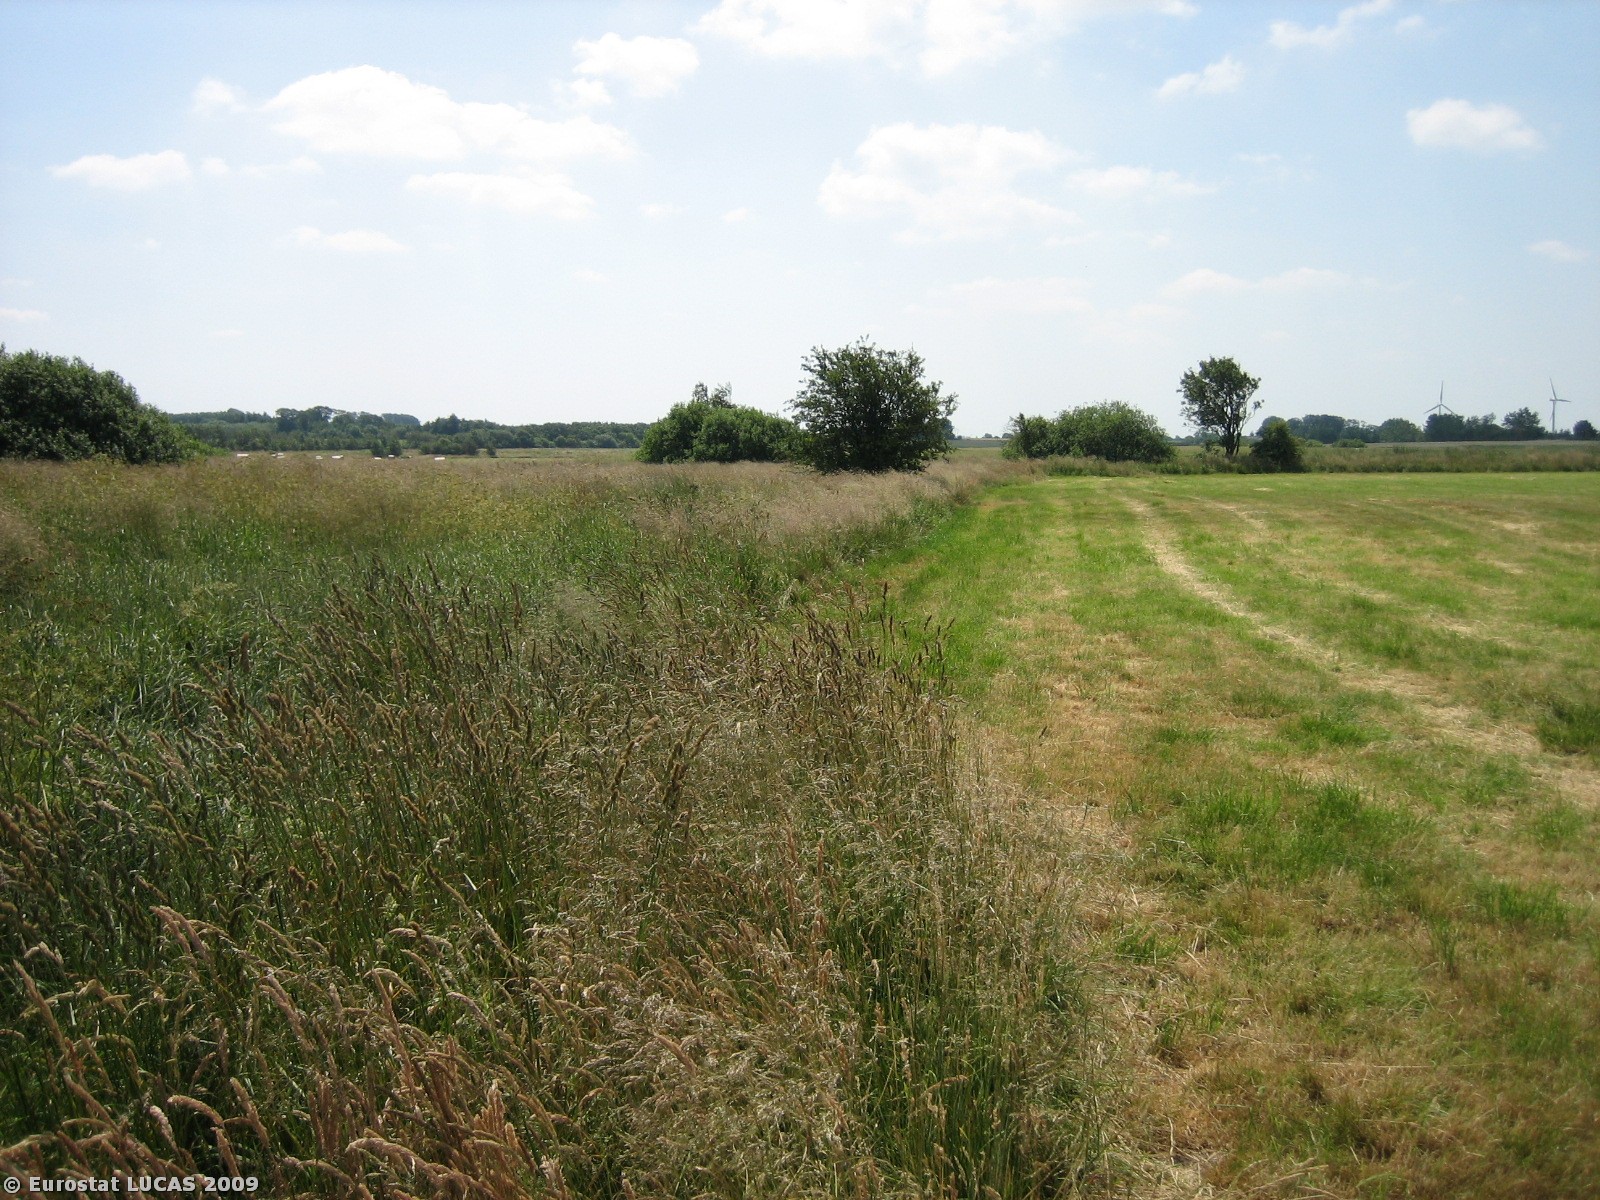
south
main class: Grassland
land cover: Grassland without tree/shrub cover
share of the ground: > 75 %
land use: Unused
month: July
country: DK
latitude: 55.4458
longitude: 8.8786
